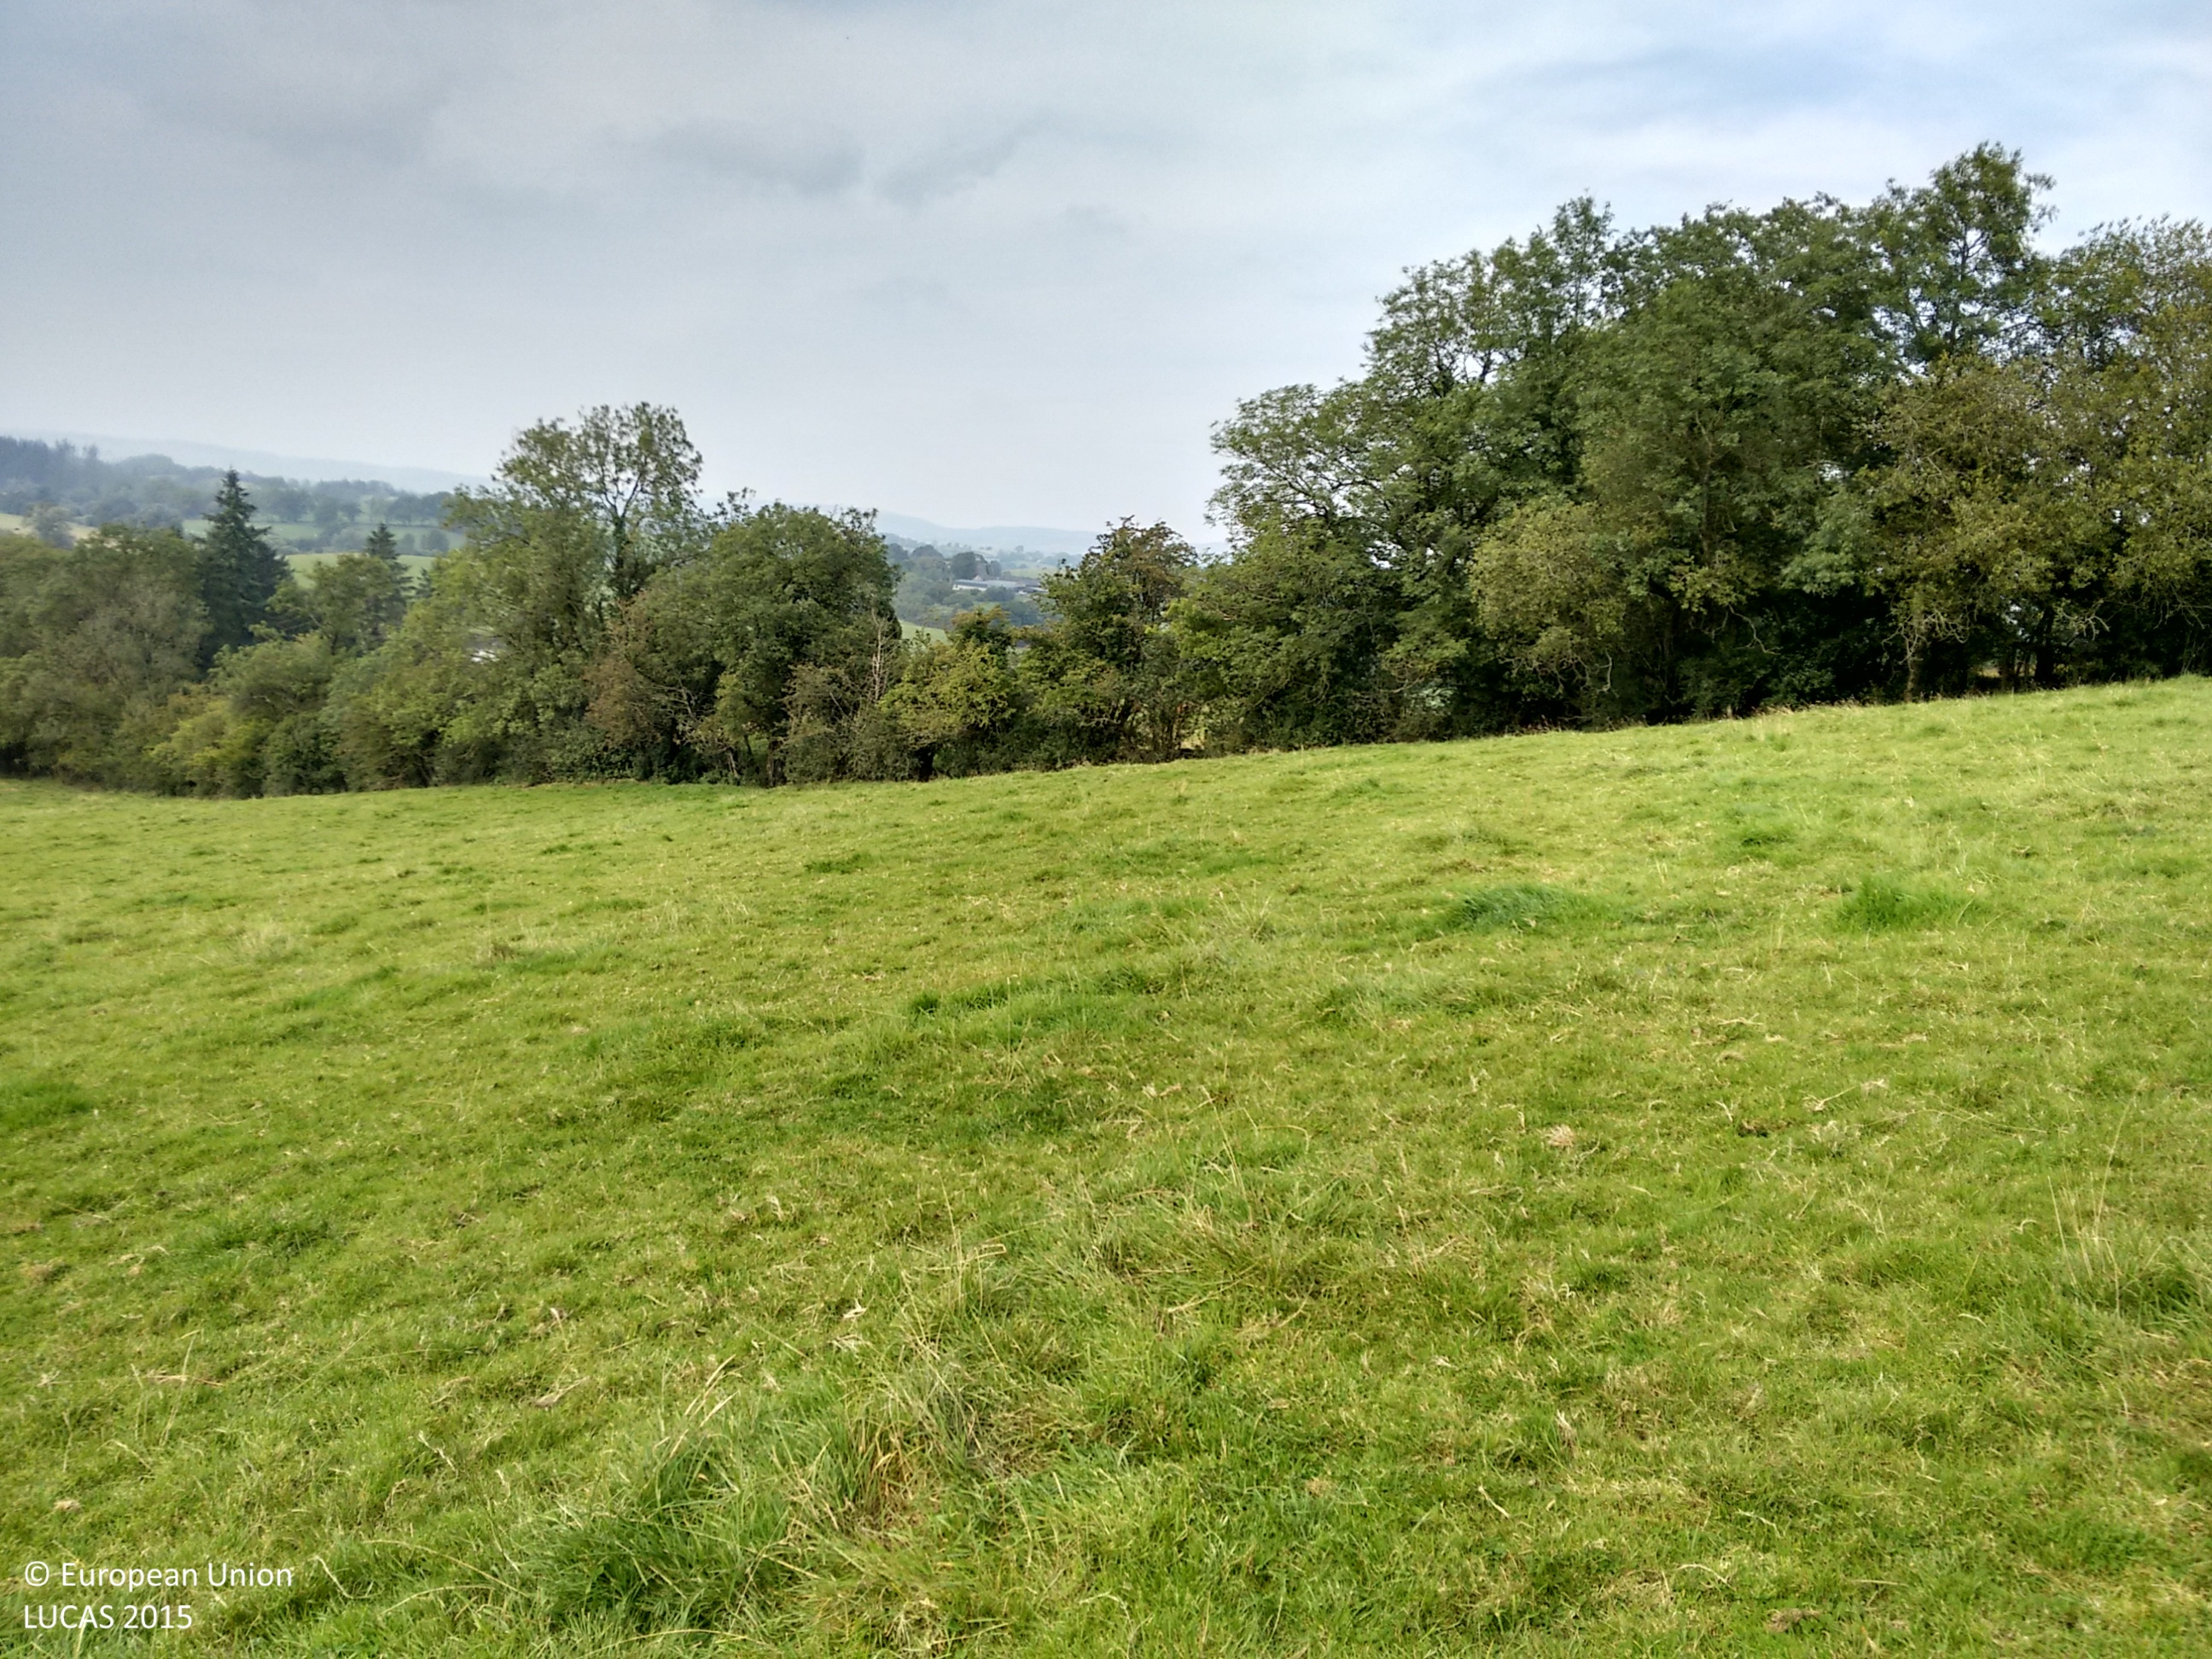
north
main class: Grassland
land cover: Grassland without tree/shrub cover
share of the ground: > 75 %
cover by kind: herbaceous plants 100 %
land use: Agriculture (excluding fallow land and kitchen gardens)
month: September
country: IE
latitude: 54.4124
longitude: -7.0124
